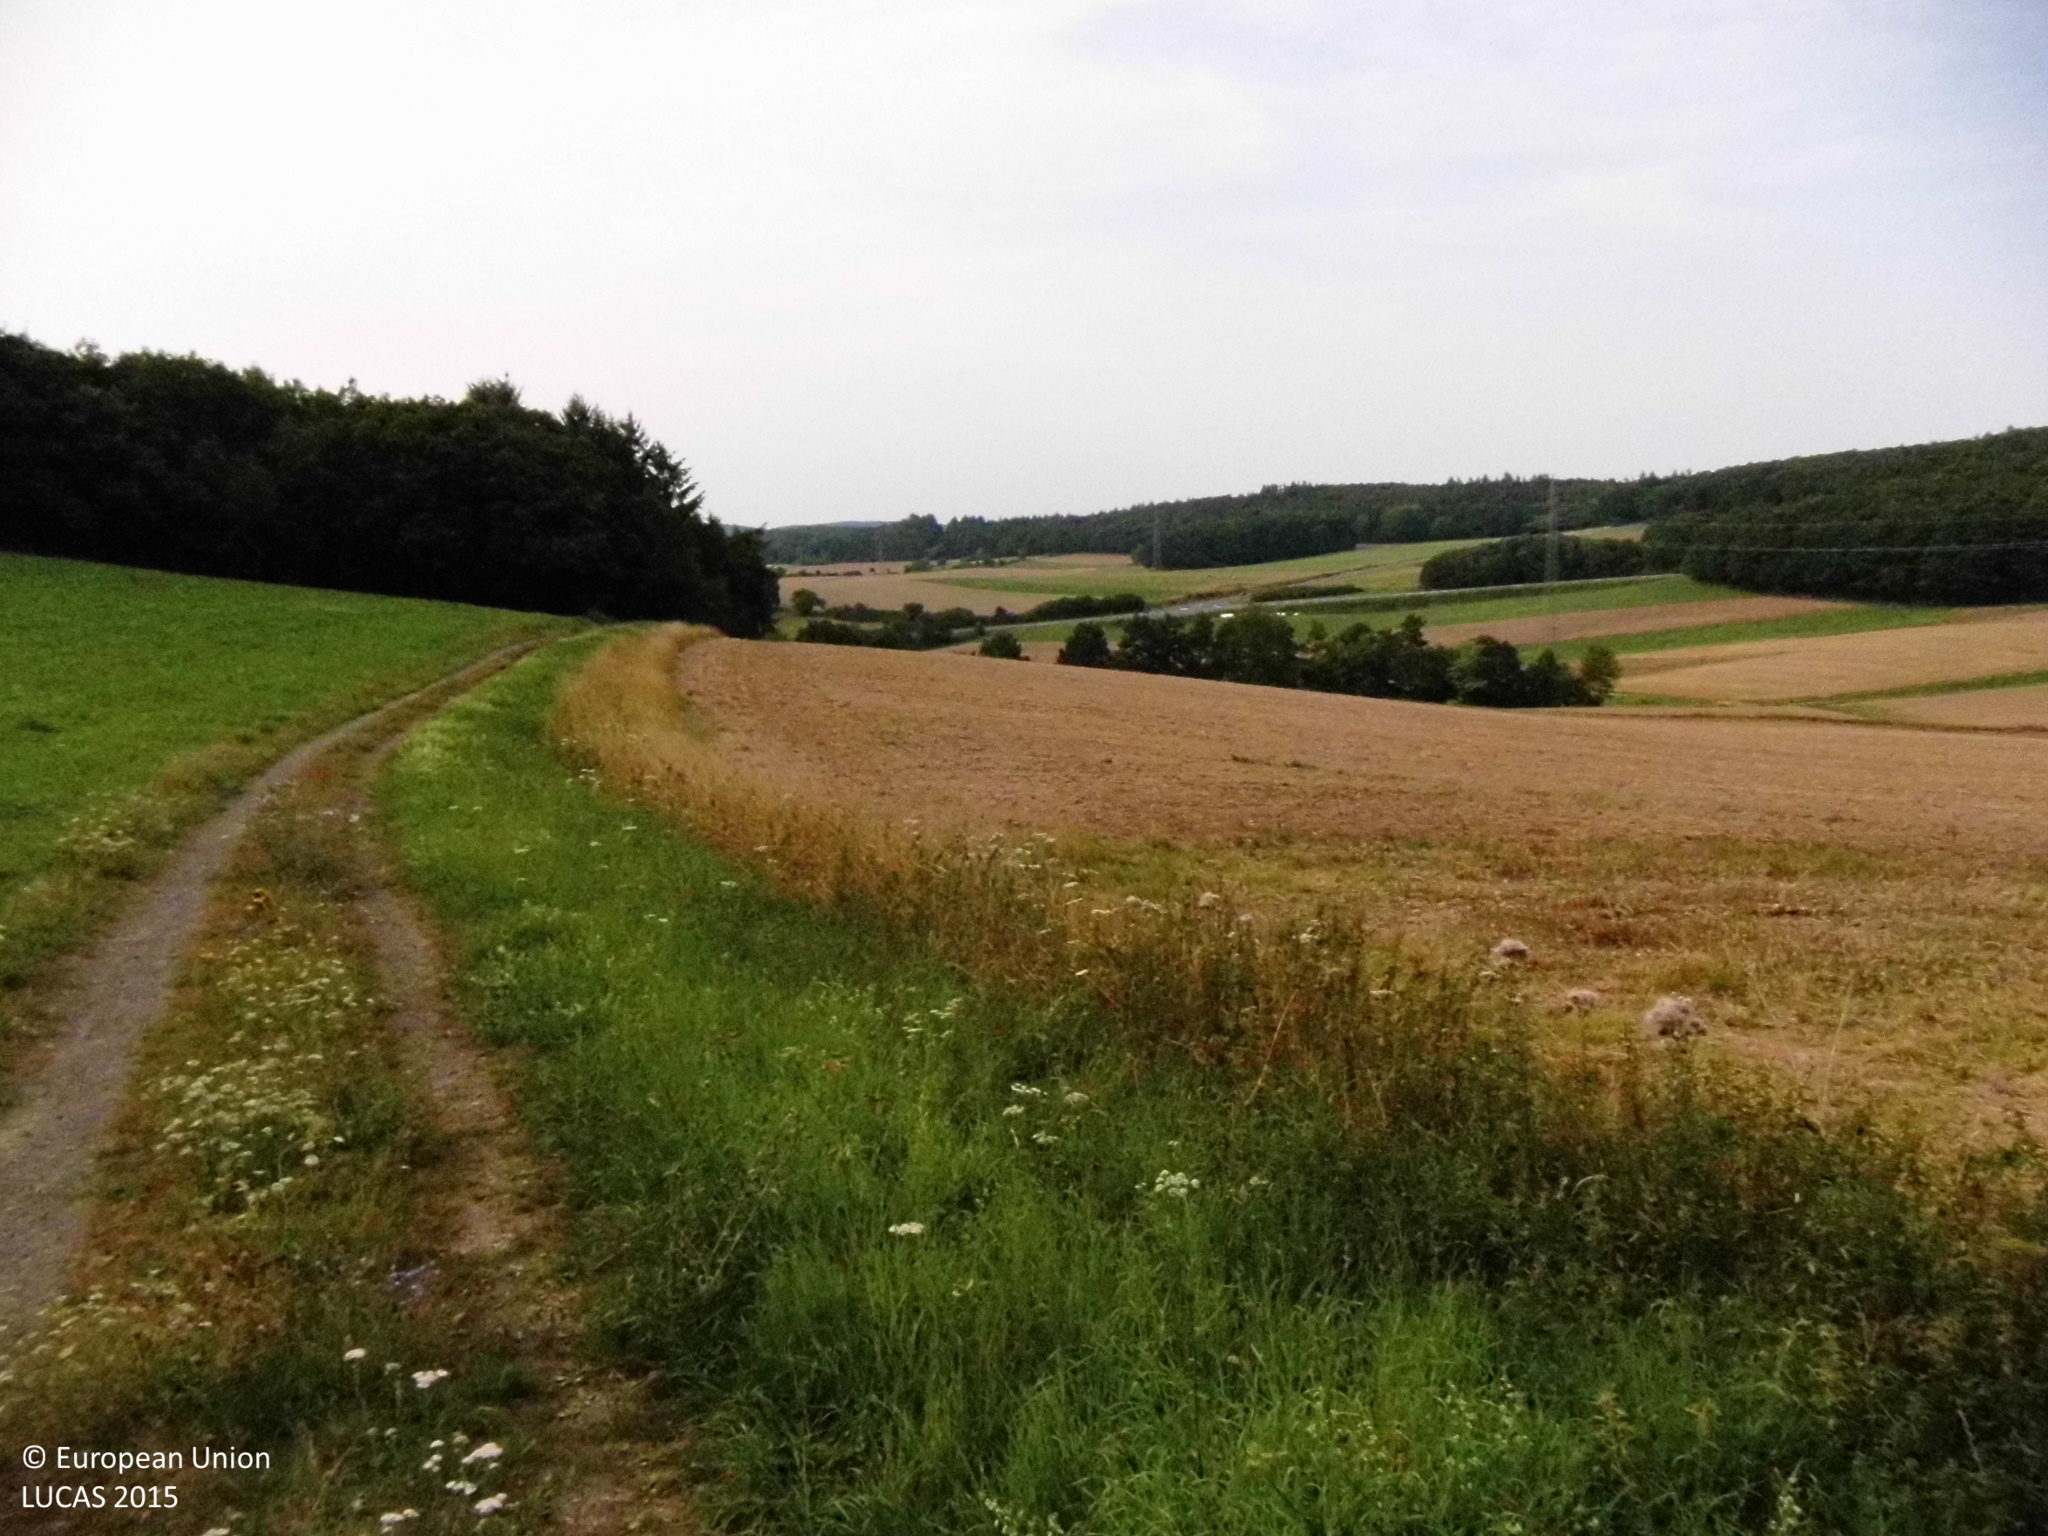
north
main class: Grassland
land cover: Grassland without tree/shrub cover
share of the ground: > 75 %
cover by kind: herbaceous plants 95 %, shrubs 5 %
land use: Agriculture (excluding fallow land and kitchen gardens)
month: August
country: DE
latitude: 50.7691
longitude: 8.5966
